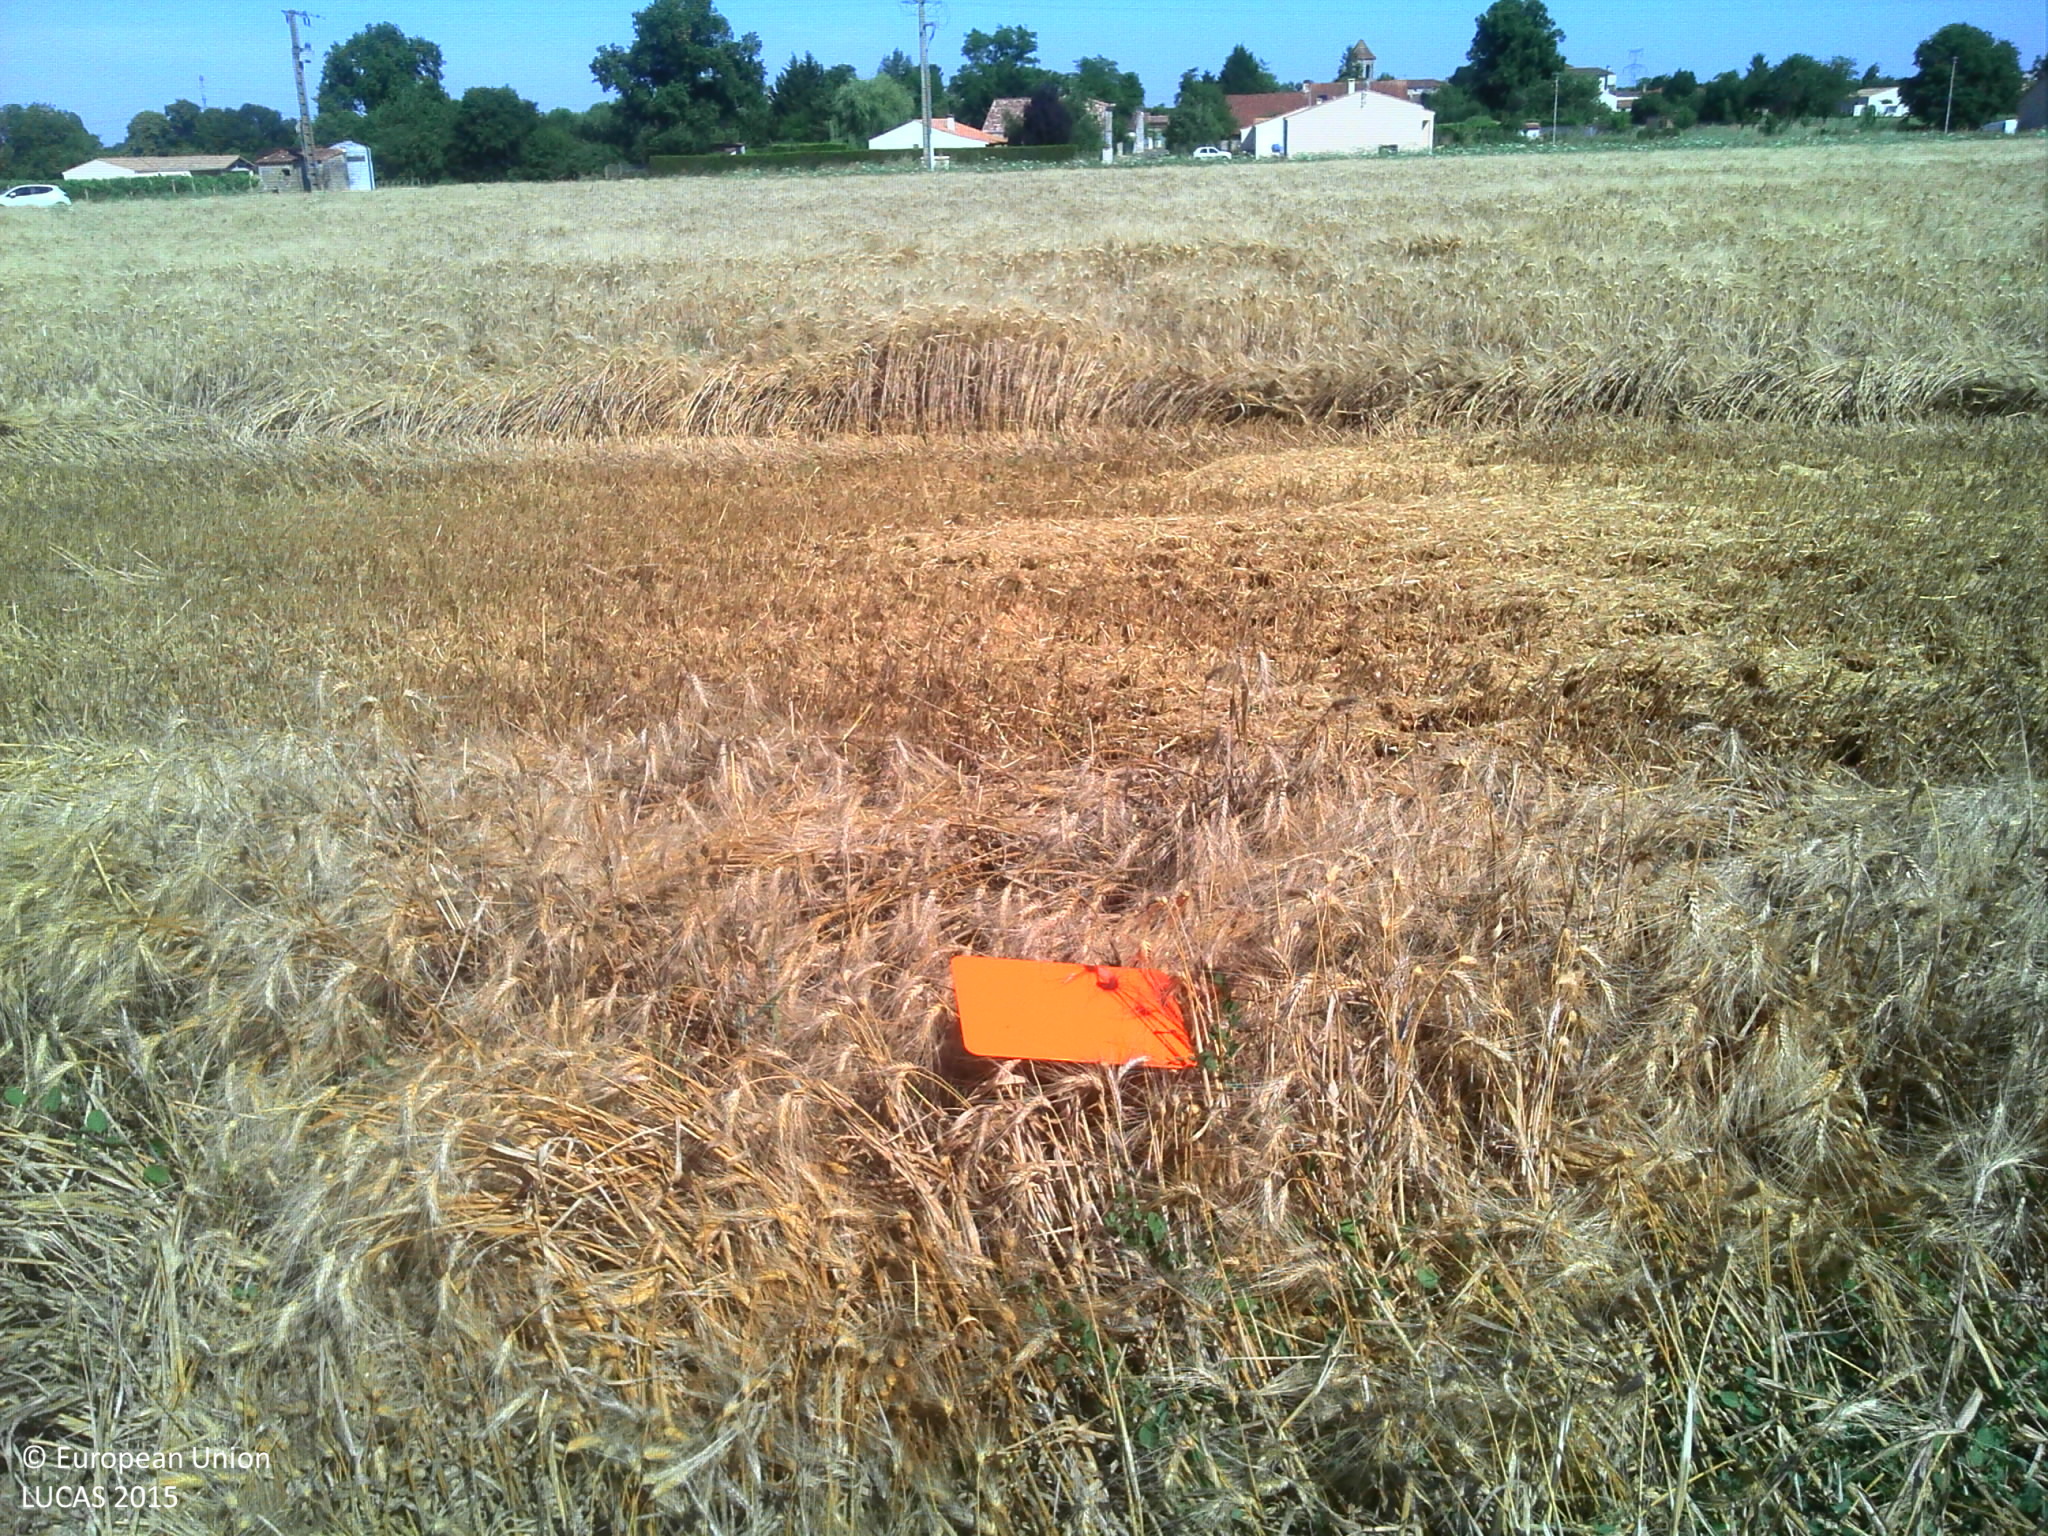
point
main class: Cropland
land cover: Common wheat
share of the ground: > 75 %
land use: Agriculture (excluding fallow land and kitchen gardens)
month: June
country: FR
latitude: 45.5846
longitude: -0.6227
